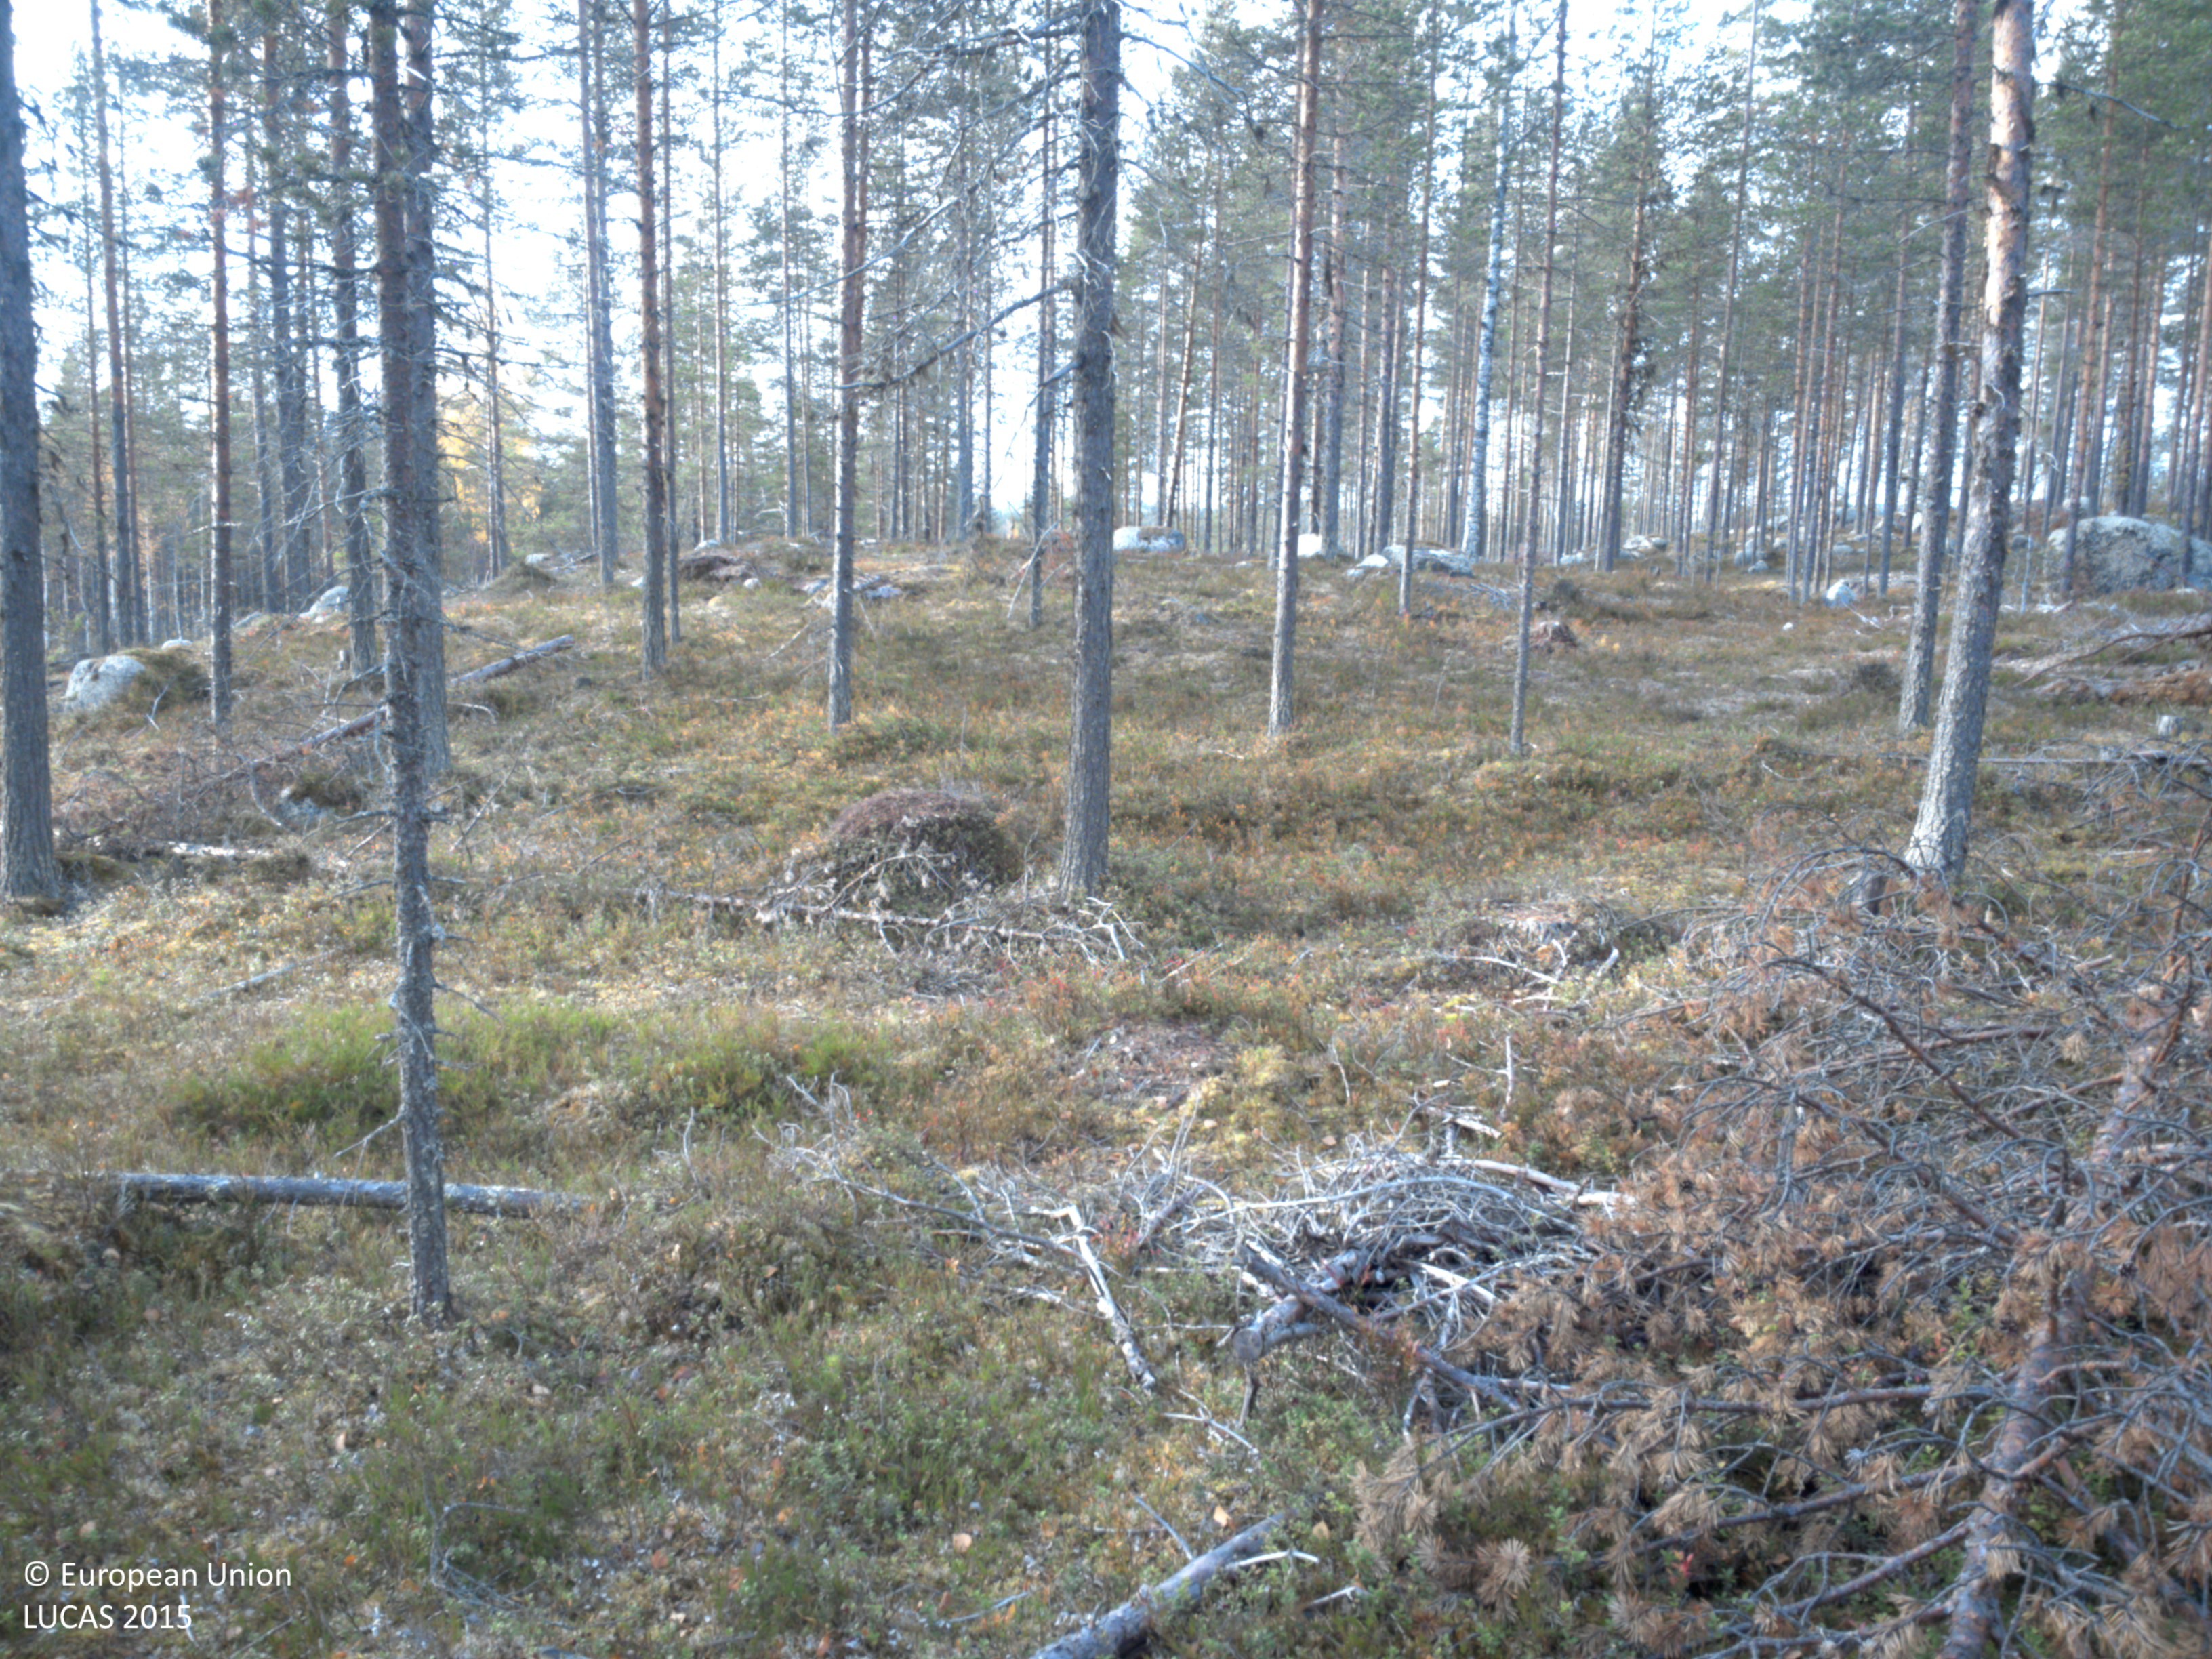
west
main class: Woodland
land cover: Pine dominated coniferous woodland
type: boreal forest
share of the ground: 50 - 75 %
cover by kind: coniferous forest trees 55 %, shrubs 30 %, lichens and mosses 10 %, herbaceous plants 5 %
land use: Forestry
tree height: > 5 m
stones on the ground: < 10 %
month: October
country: SE
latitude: 64.8443
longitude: 19.1388
